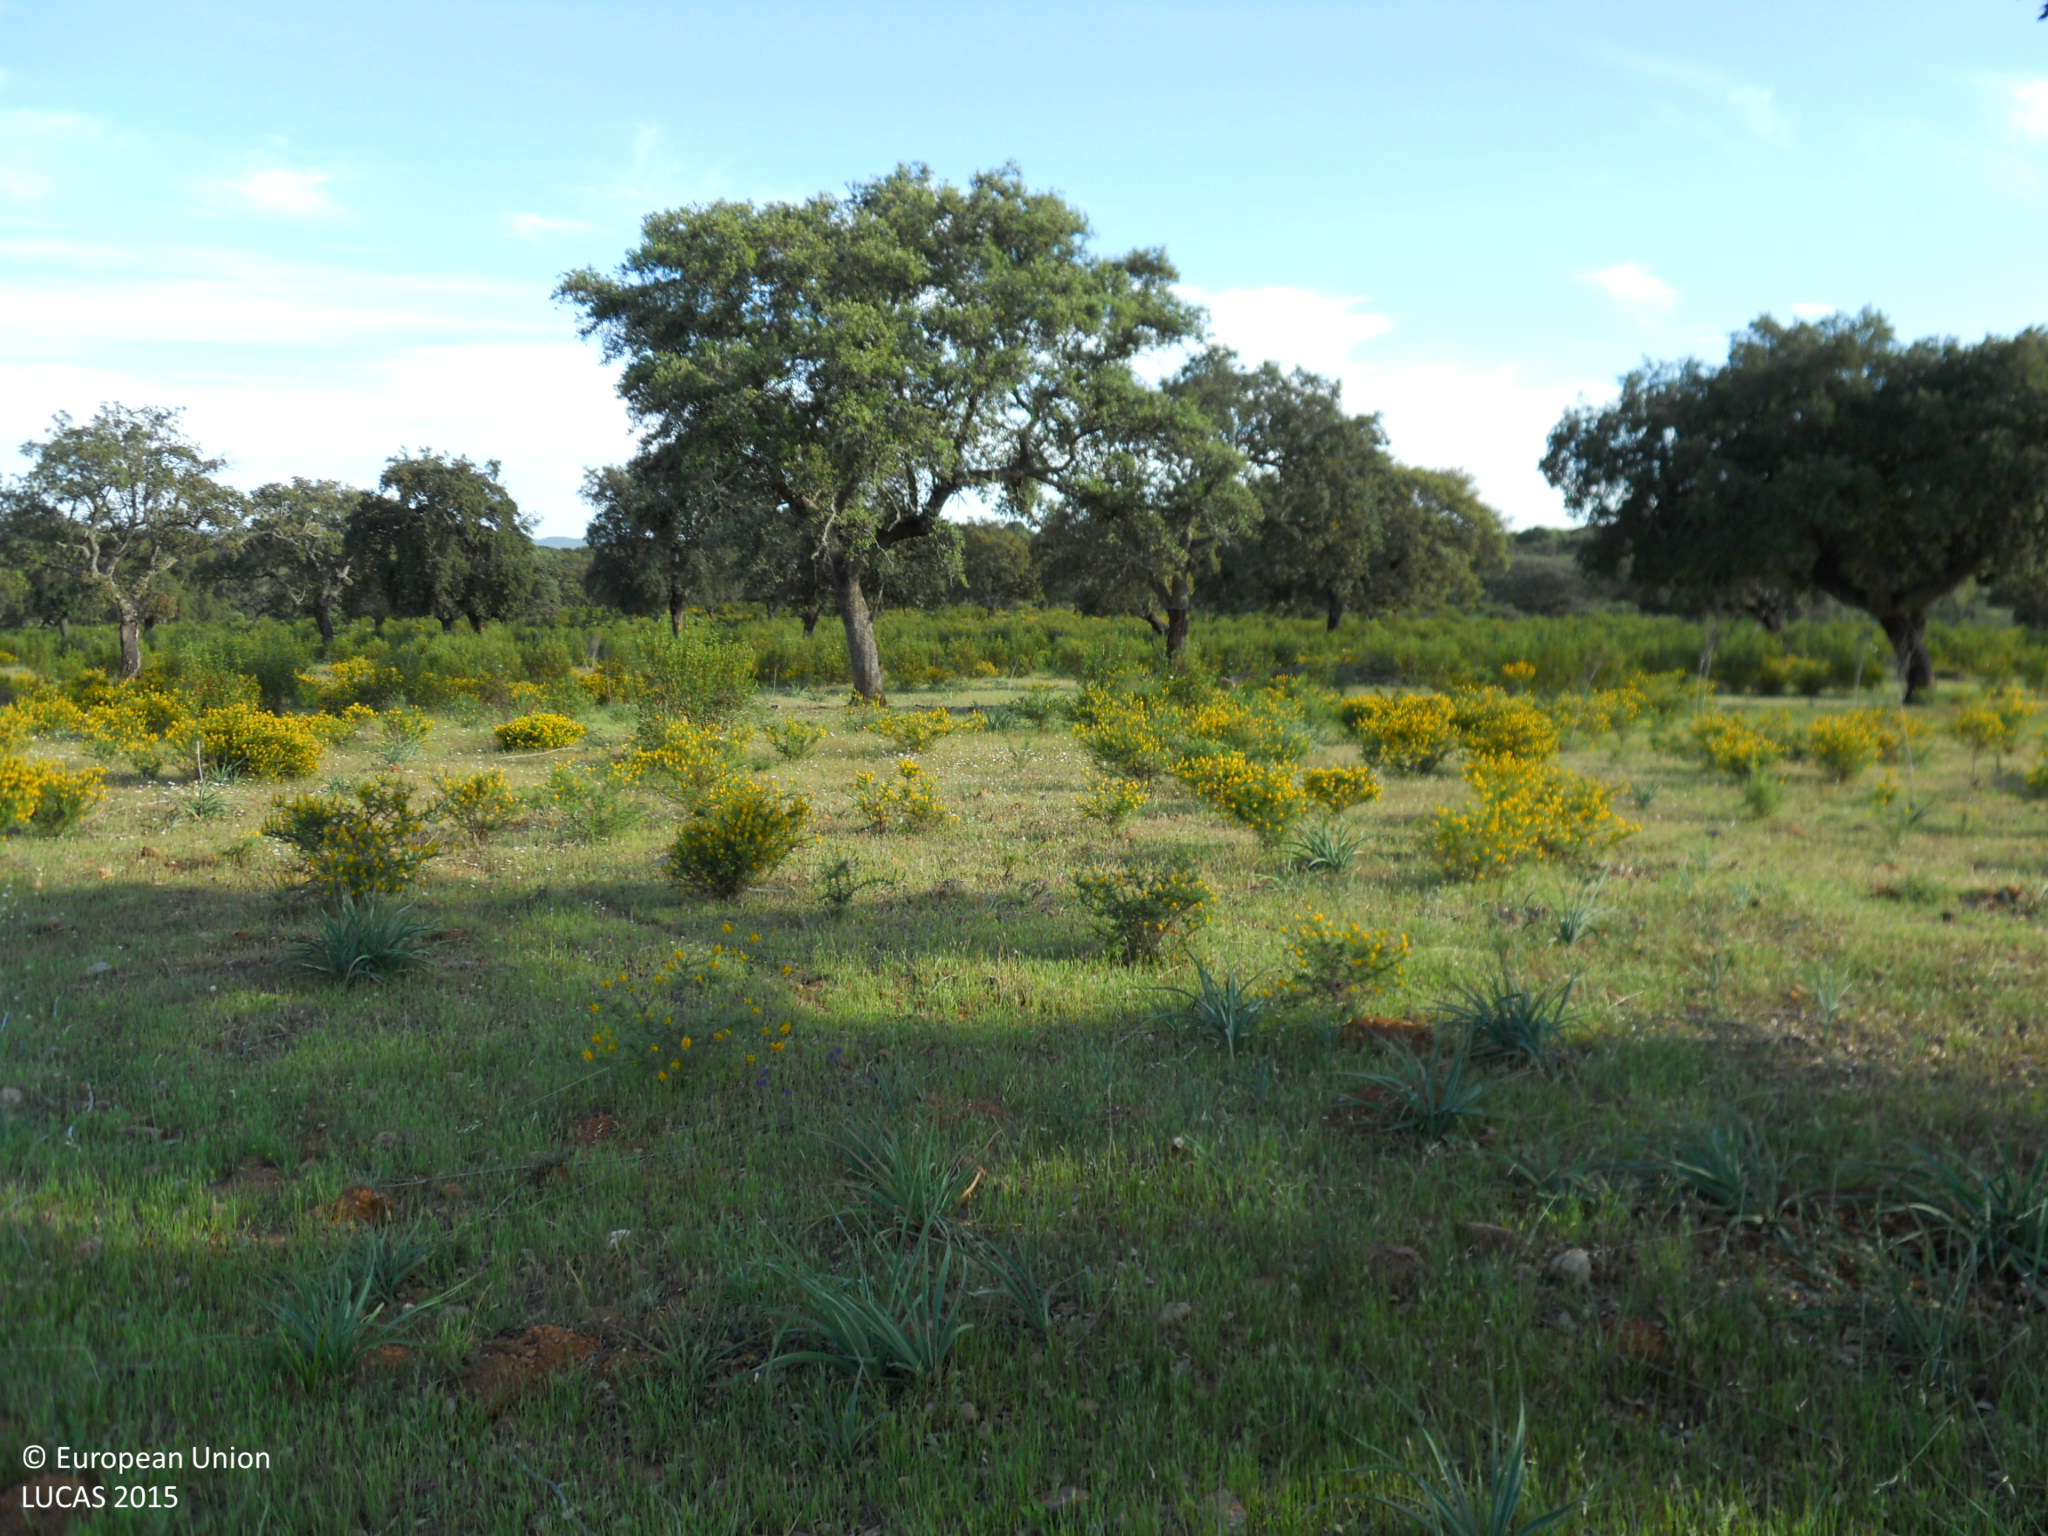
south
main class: Woodland
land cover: Broadleaved woodland
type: broadleaved evergreen forest
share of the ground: 50 - 75 %
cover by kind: broadleaved forest trees 70 %, herbaceous plants 20 %, shrubs 10 %
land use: Forestry
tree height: > 5 m
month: April
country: ES
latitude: 39.3562
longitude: -6.8214
